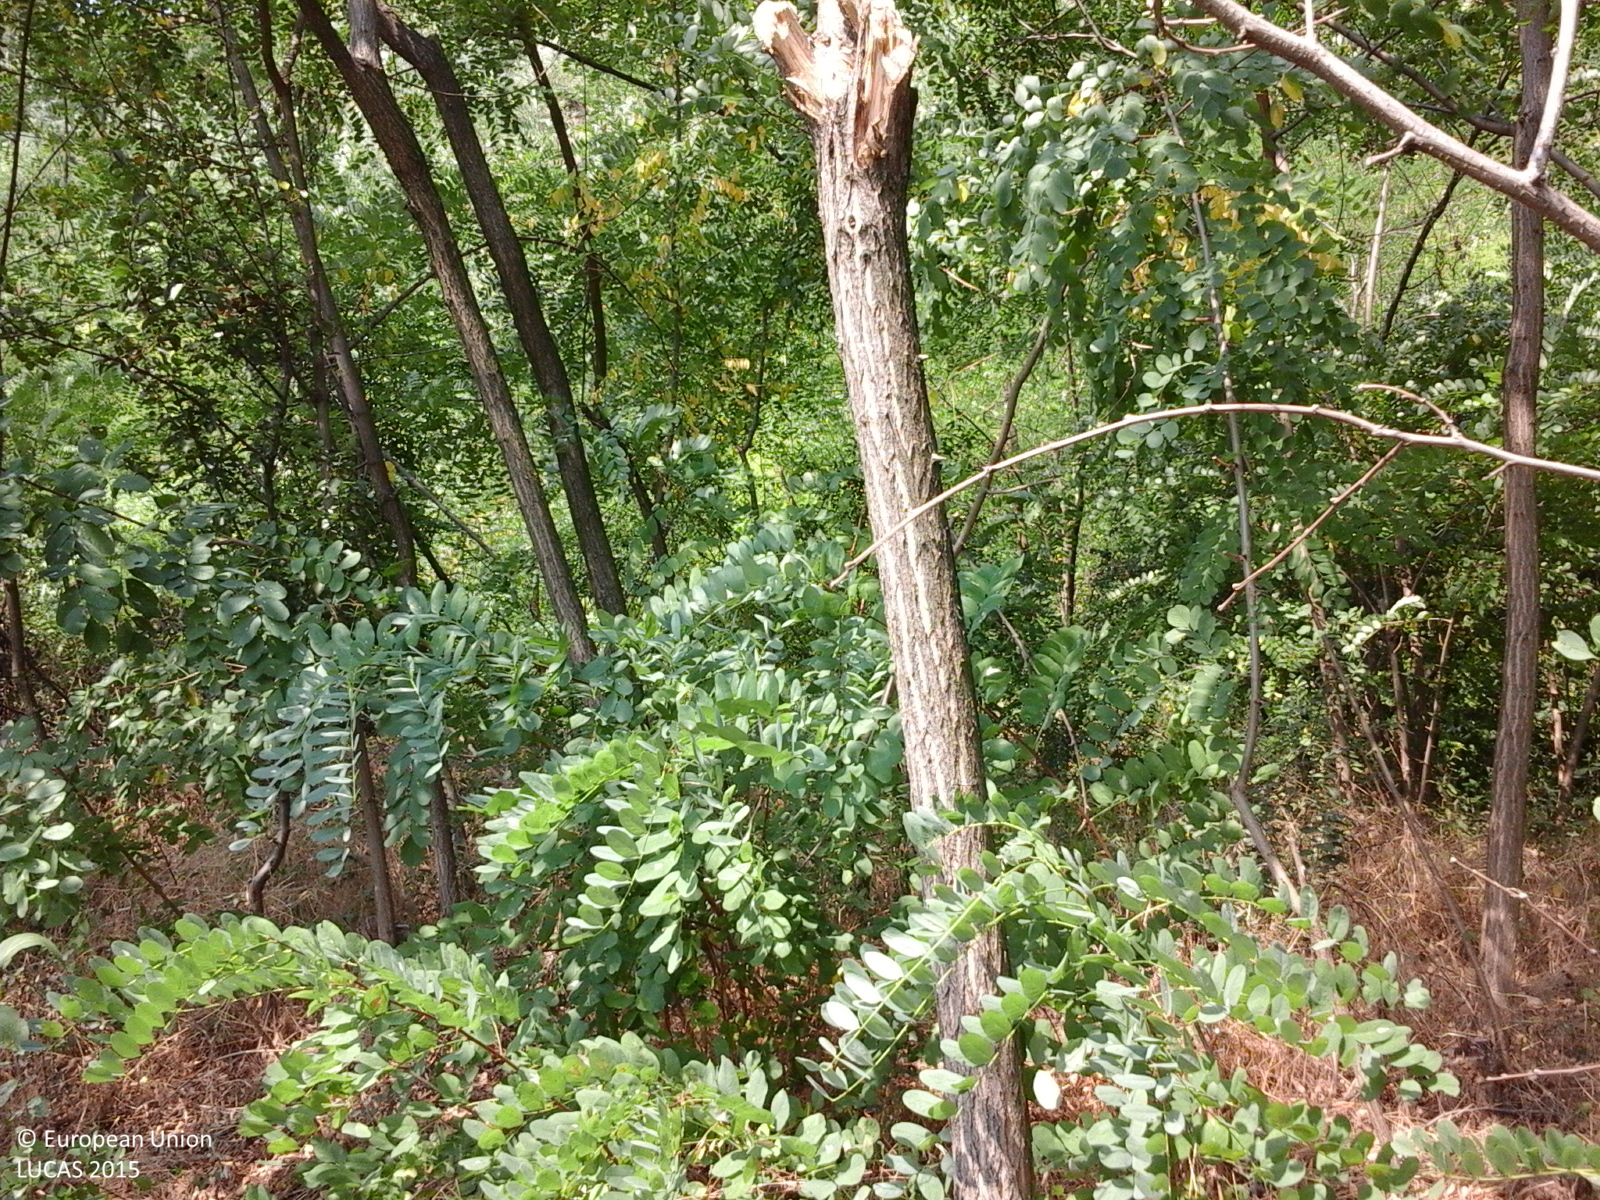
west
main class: Woodland
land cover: Broadleaved woodland
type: exotic forest
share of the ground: > 75 %
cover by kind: broadleaved forest trees 100 %
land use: Forestry
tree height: > 5 m
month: August
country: RO
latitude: 44.5211
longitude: 23.3753
